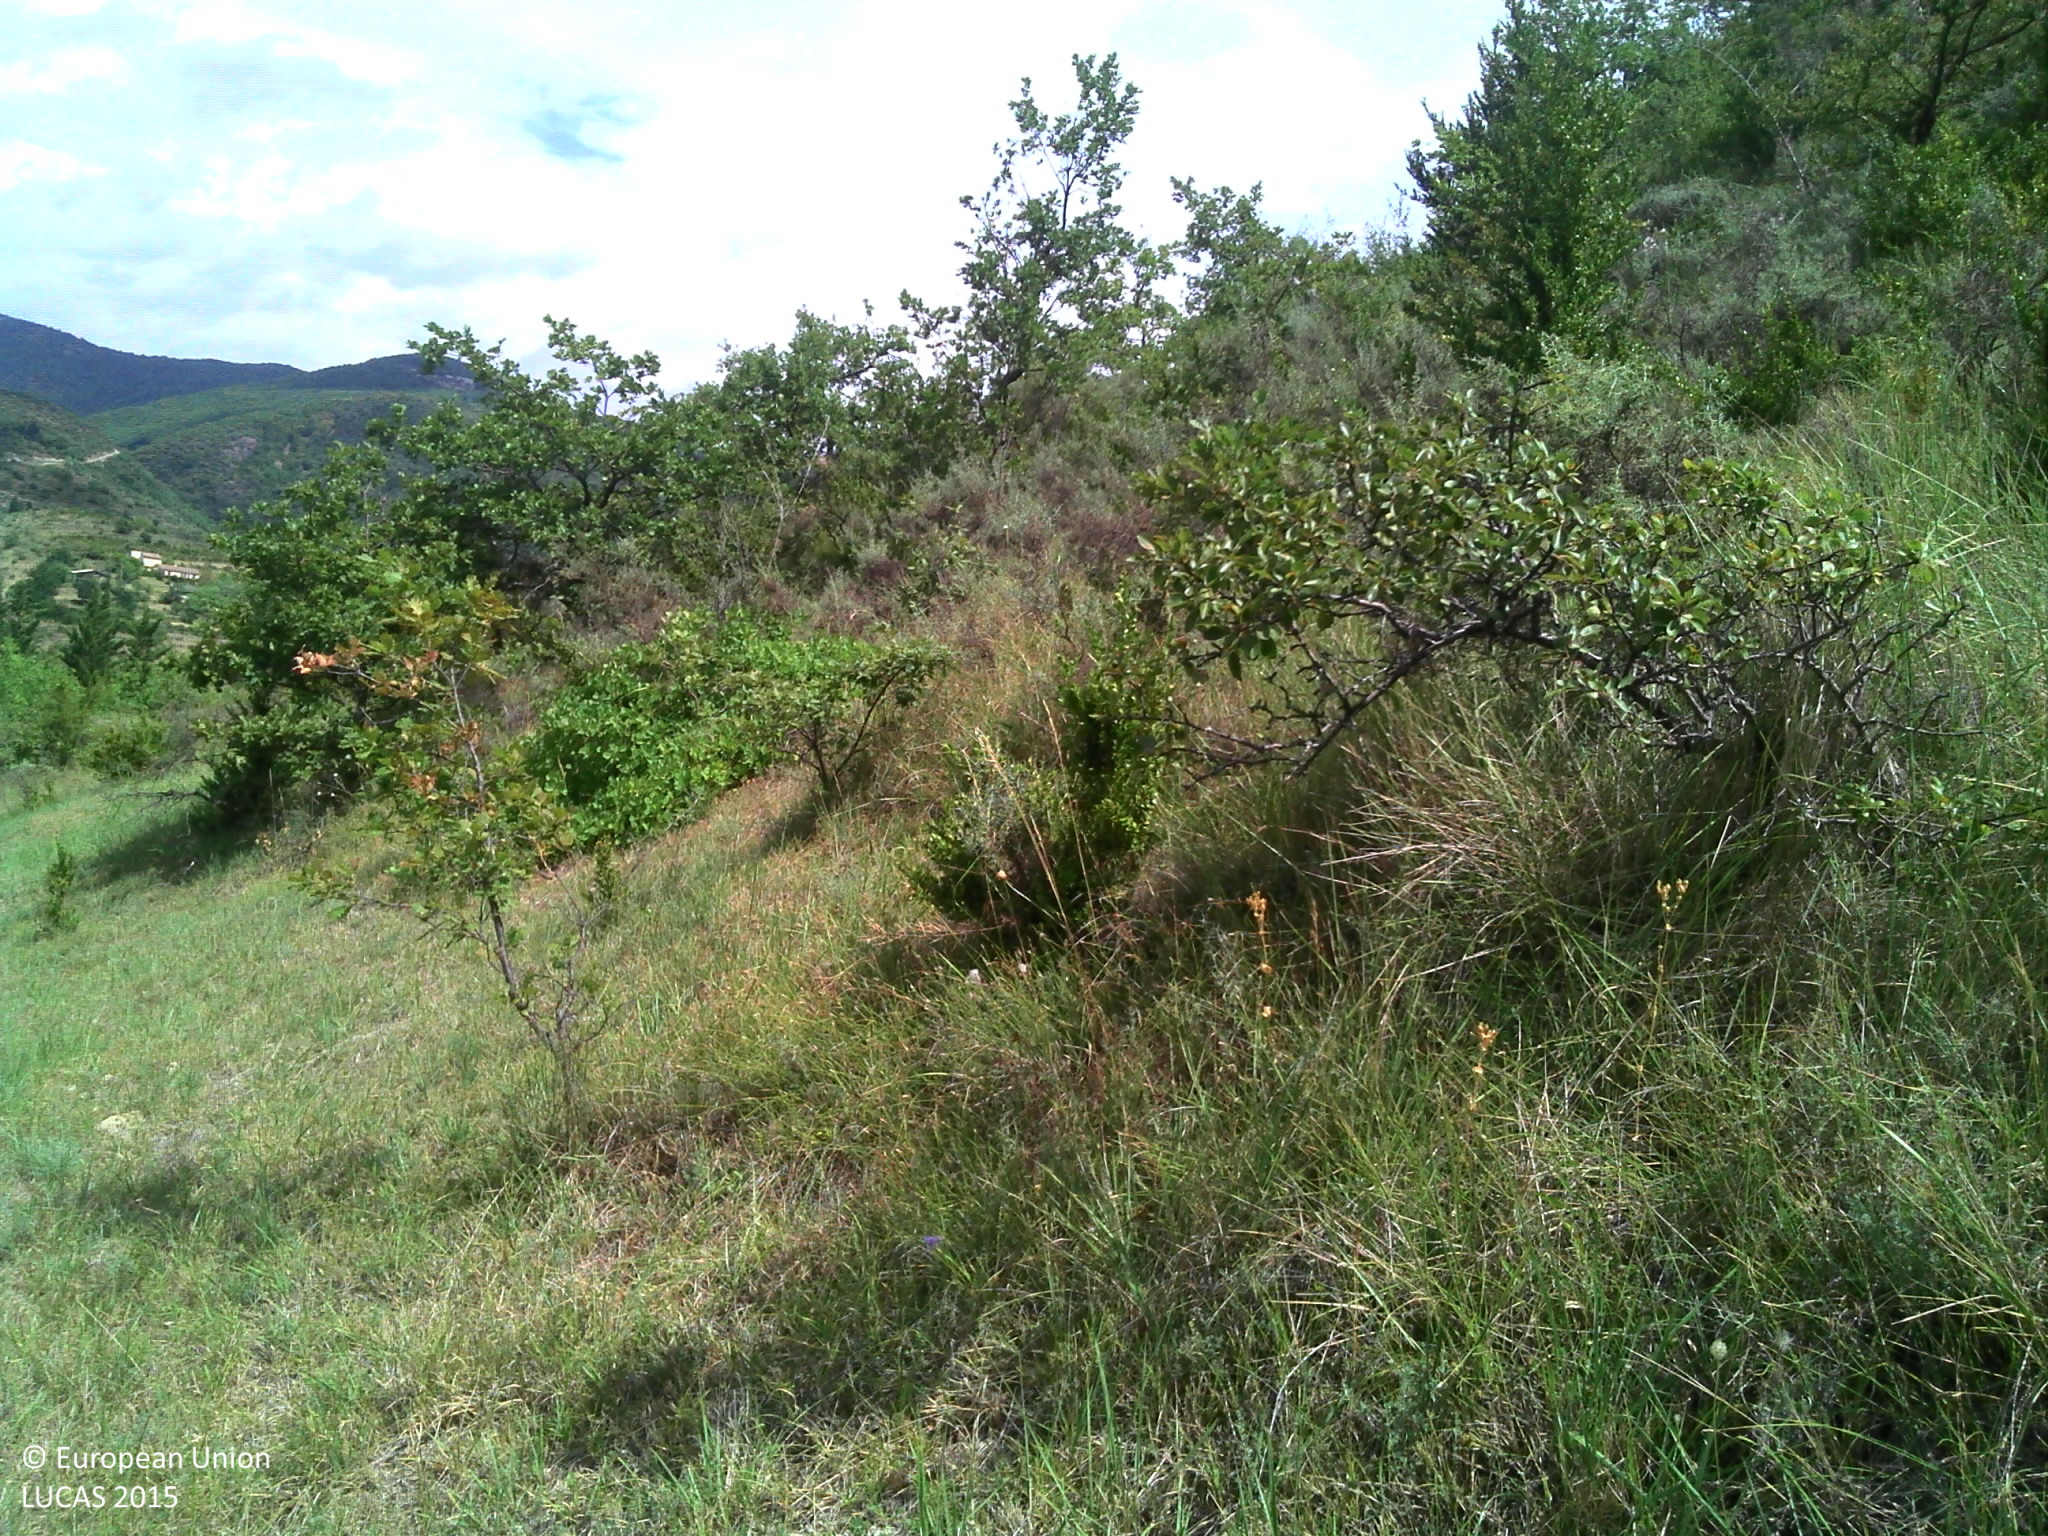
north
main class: Woodland
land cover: Broadleaved woodland
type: broadleaved evergreen forest
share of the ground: > 75 %
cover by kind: broadleaved forest trees 100 %
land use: Semi-natural and natural areas not in use
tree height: > 5 m
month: July
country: FR
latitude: 44.7373
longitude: 4.6643
